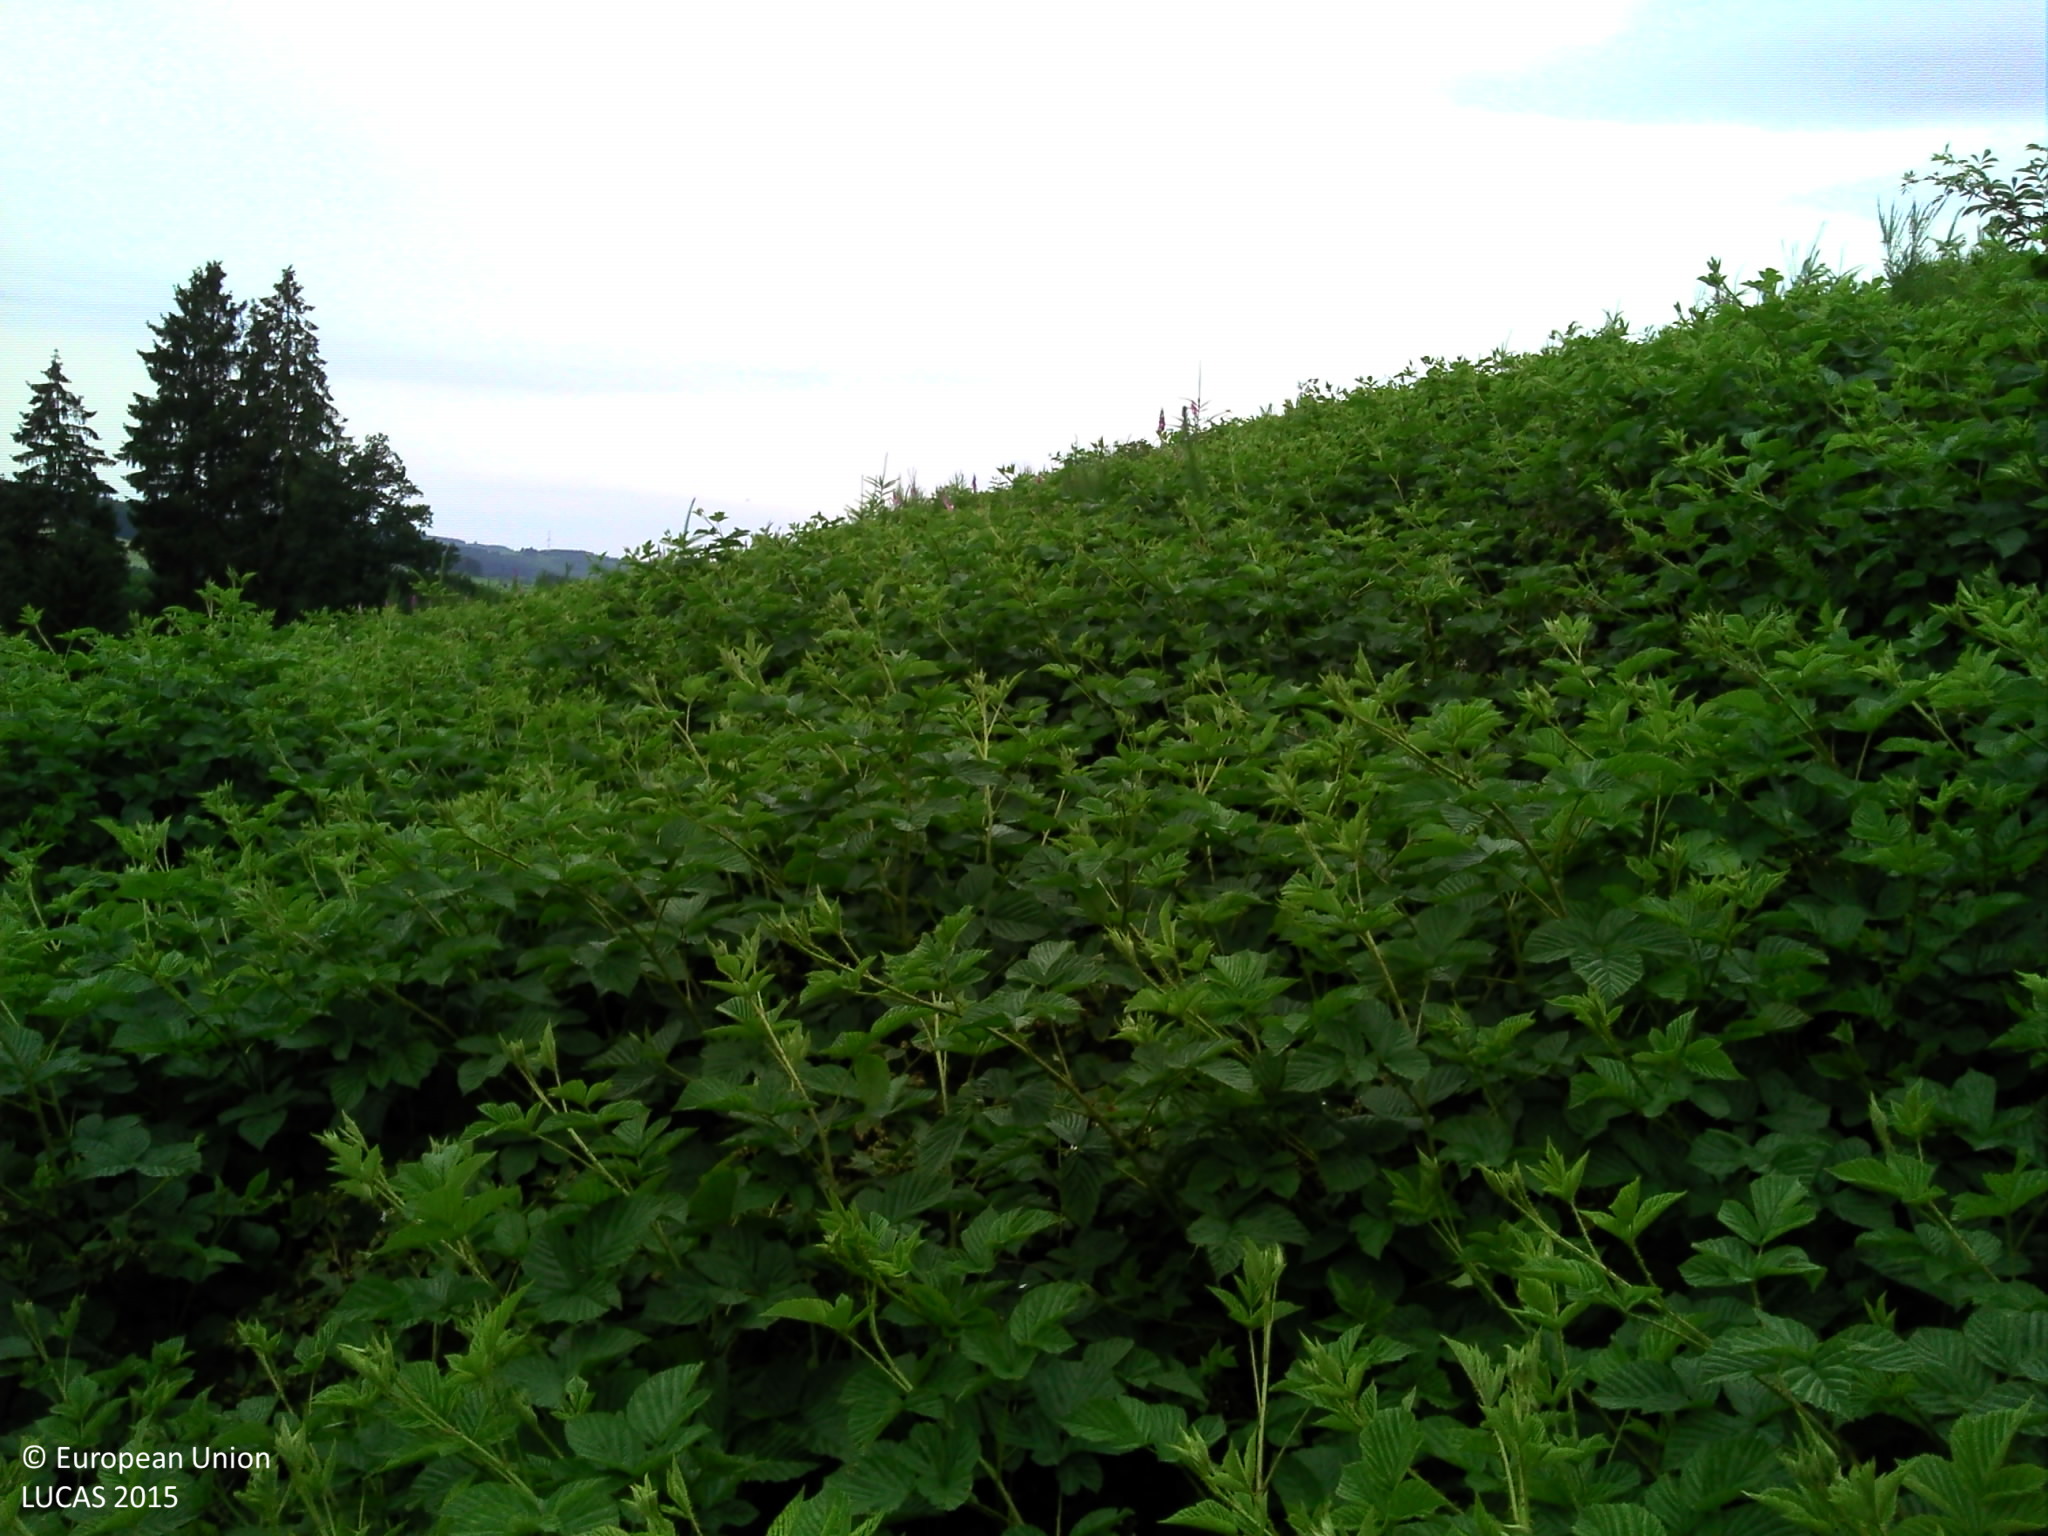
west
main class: Shrubland
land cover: Shrubland without tree cover
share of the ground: > 75 %
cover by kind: herbaceous plants 65 %, shrubs 35 %
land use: Forestry
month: July
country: BE
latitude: 50.2722
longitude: 5.8879
